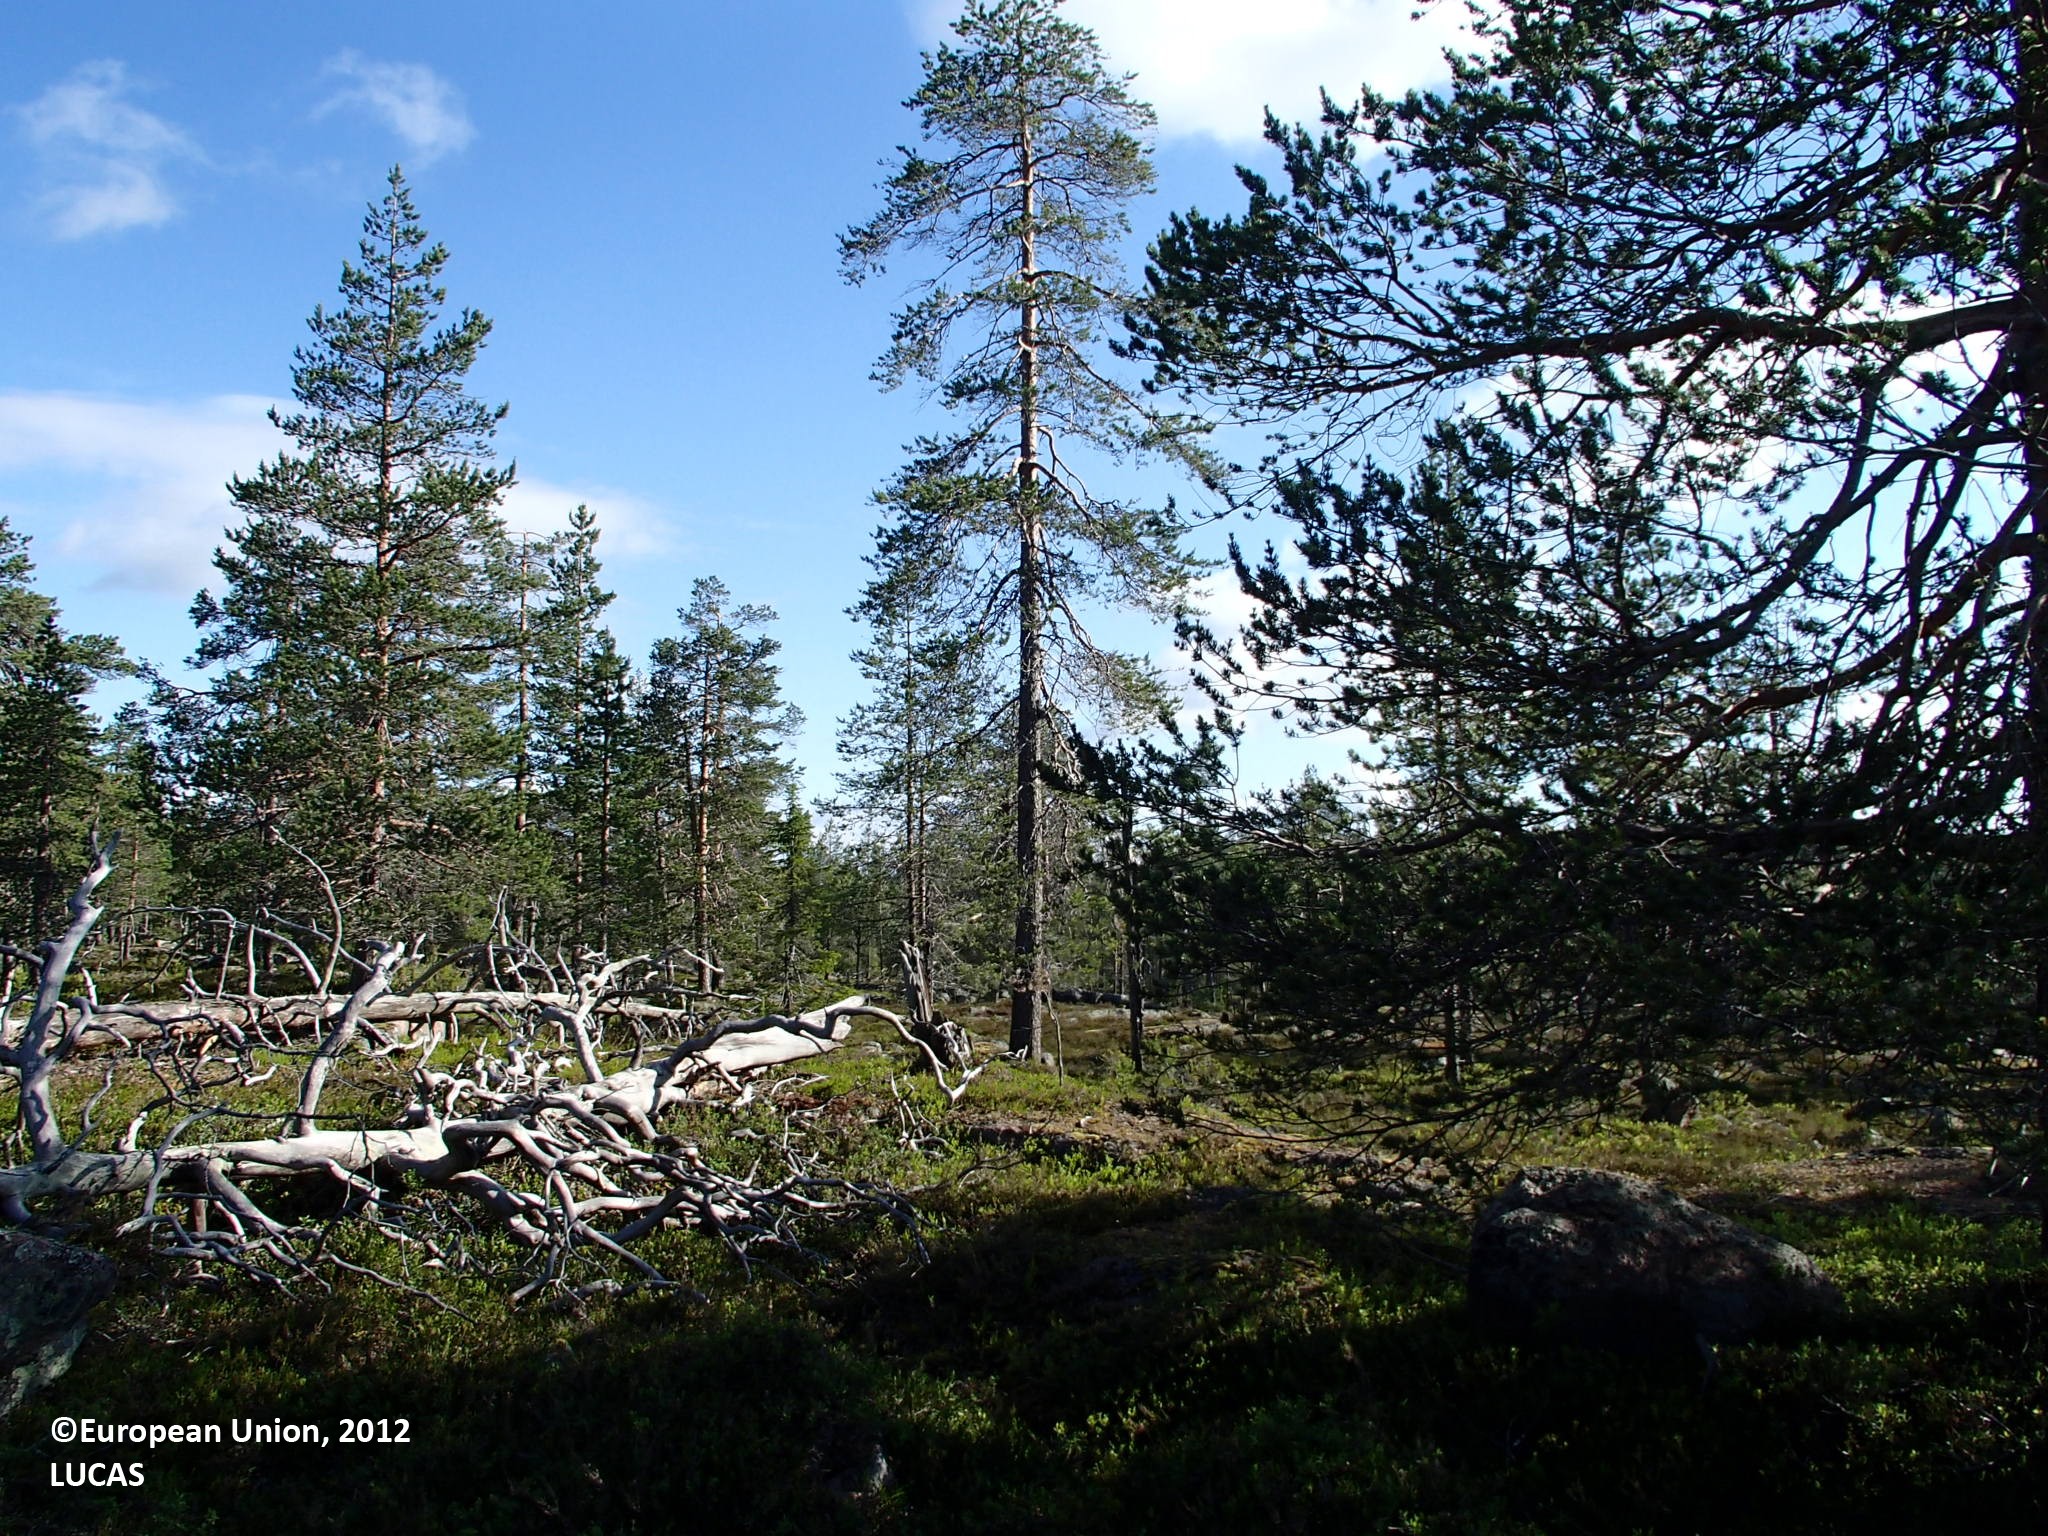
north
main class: Woodland
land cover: Pine dominated coniferous woodland
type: boreal forest
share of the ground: 10 - 25 %
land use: Forestry
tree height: > 5 m
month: July
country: FI
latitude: 66.9102
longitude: 26.6510
